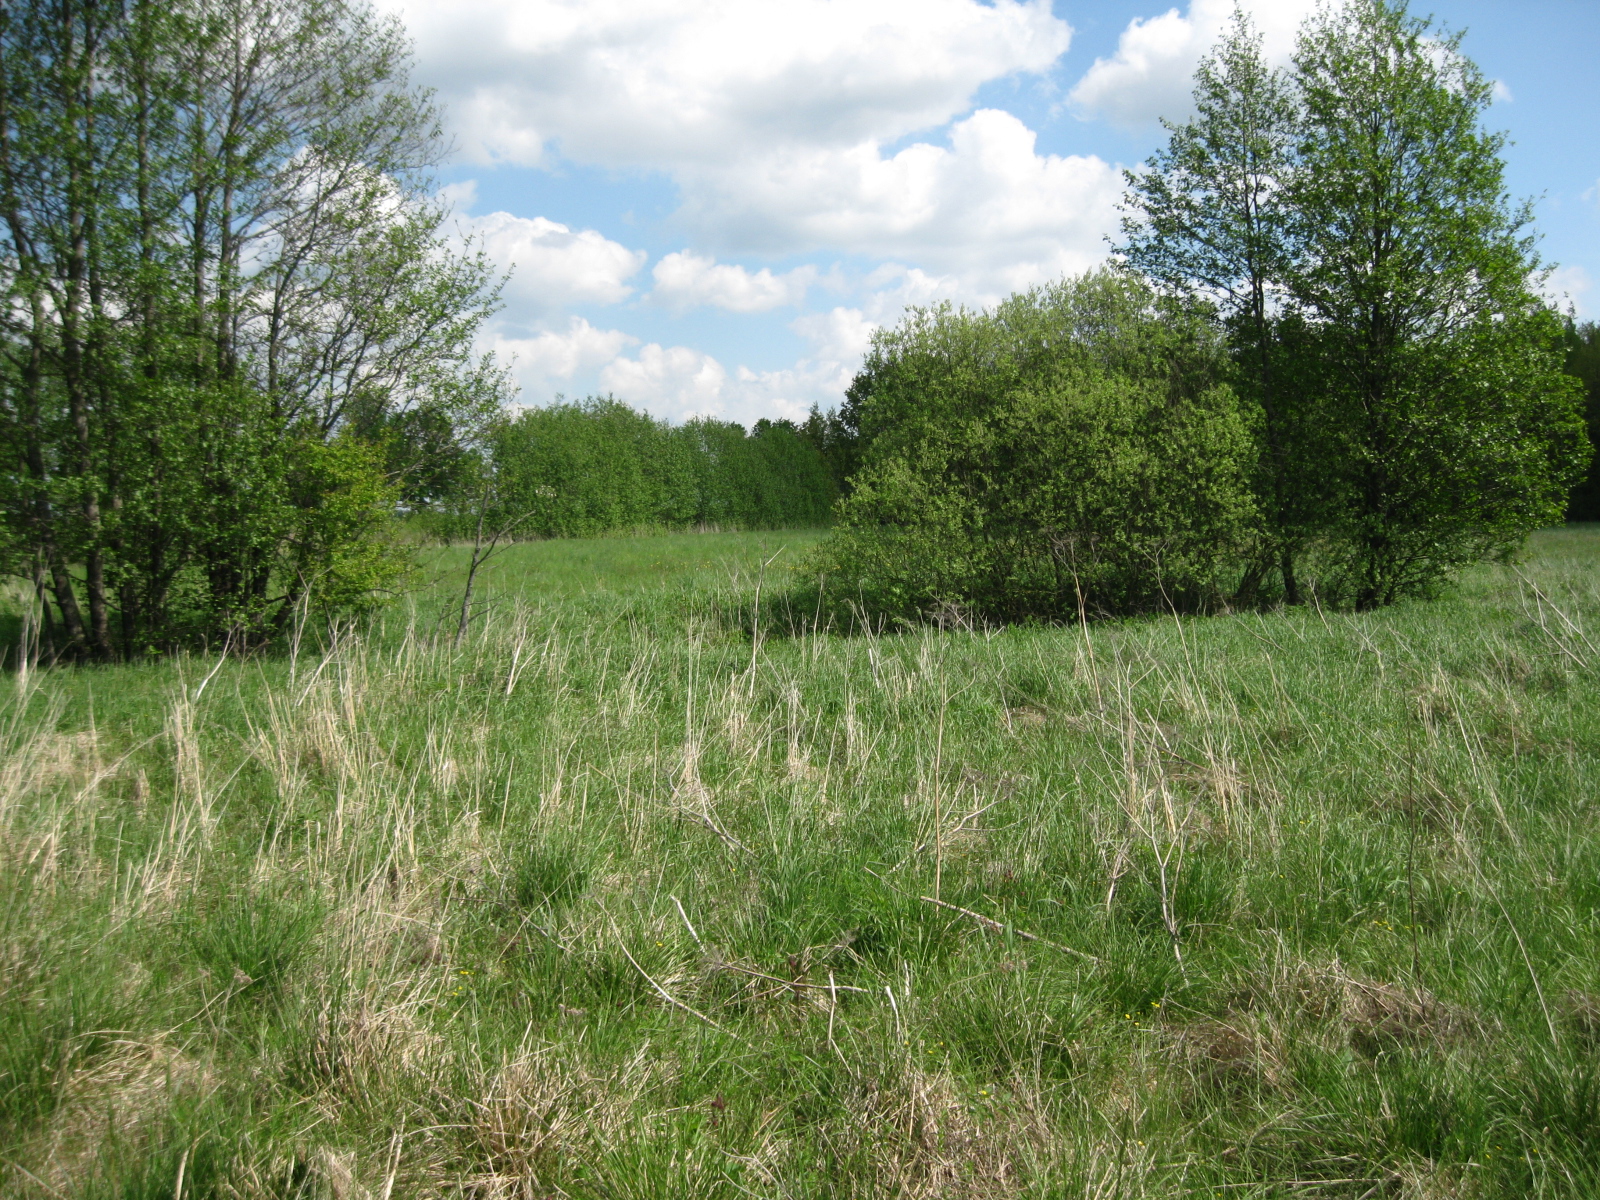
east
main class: Grassland
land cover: Grassland without tree/shrub cover
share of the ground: > 75 %
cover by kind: herbaceous plants 100 %
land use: Agriculture (excluding fallow land and kitchen gardens)
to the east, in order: Grassland without tree/shrub cover; Ditches and canals; Abandoned hedges; Grassland without tree/shrub cover; Broadleaved woodland; Grassland without tree/shrub cover; Paved roads, cycling and walking lanes; Grassland without tree/shrub cover; Lines of trees; Common wheat
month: May
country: LT
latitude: 56.0399
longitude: 24.1348
